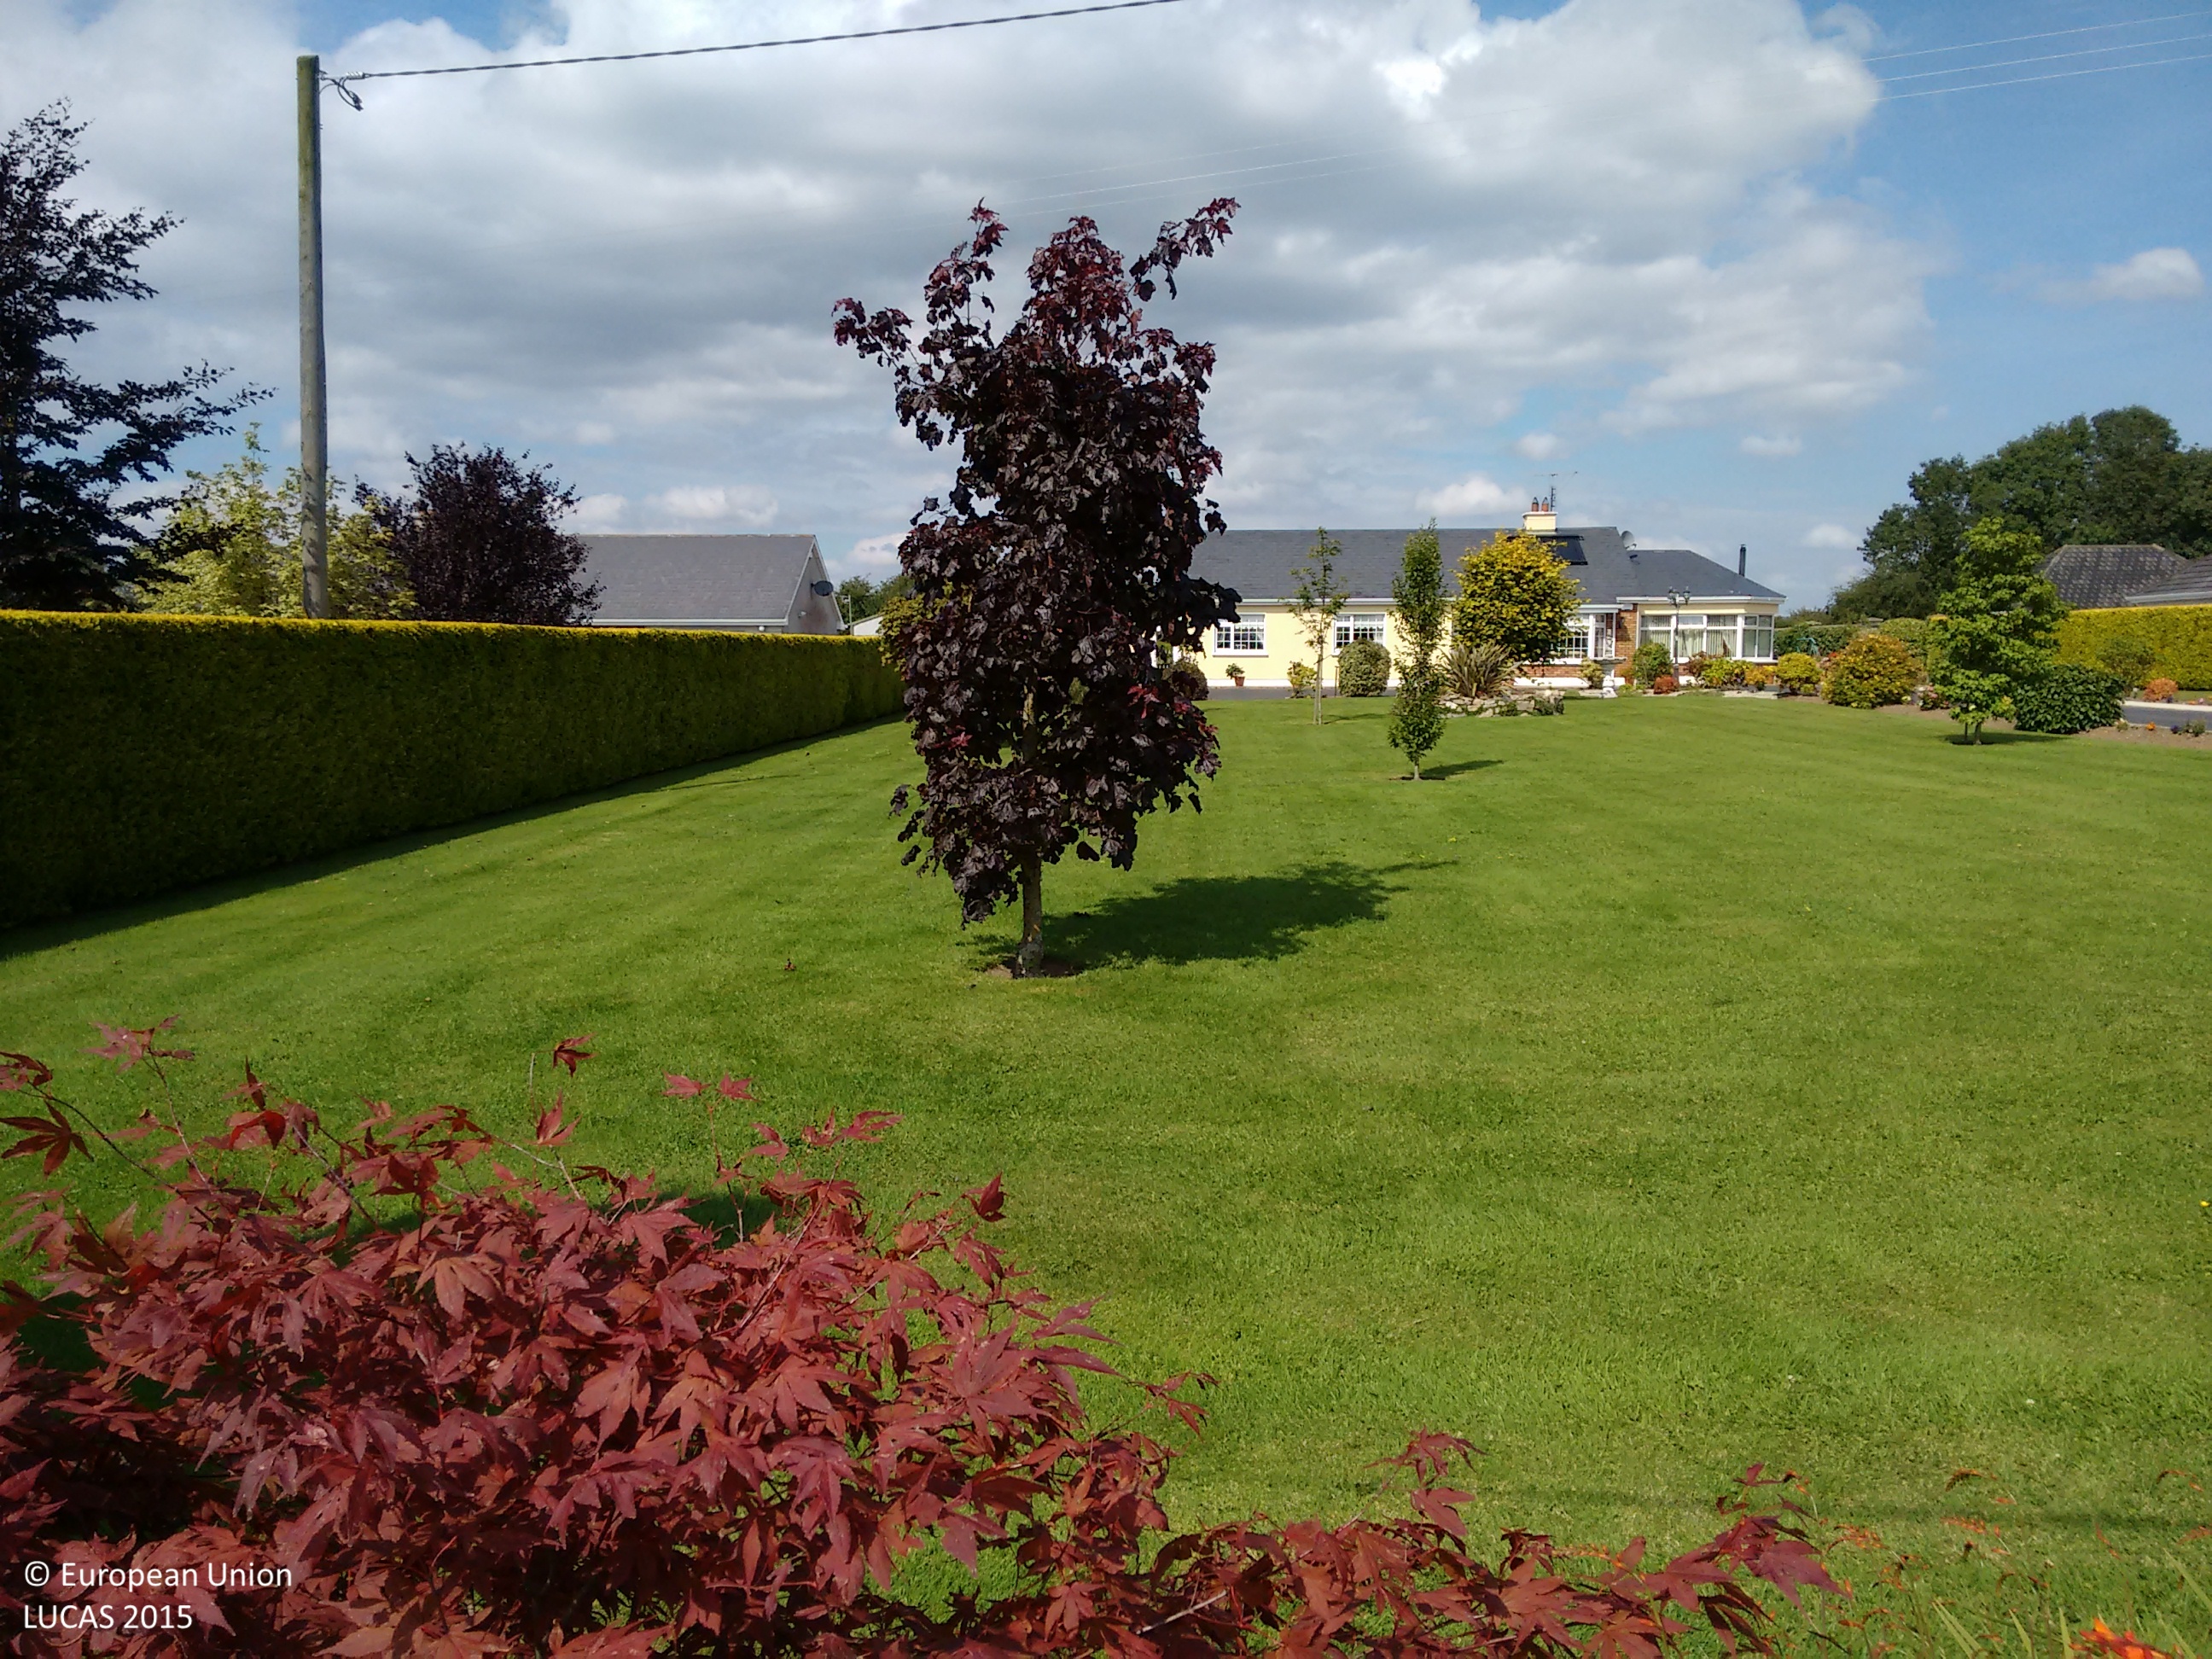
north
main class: Grassland
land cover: Grassland with sparse tree/shrub cover
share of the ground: > 75 %
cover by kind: herbaceous plants 90 %, broadleaved forest trees 5 %, shrubs 5 %
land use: Residential
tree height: < 5 m
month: August
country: IE
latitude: 52.9990
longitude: -7.4872
